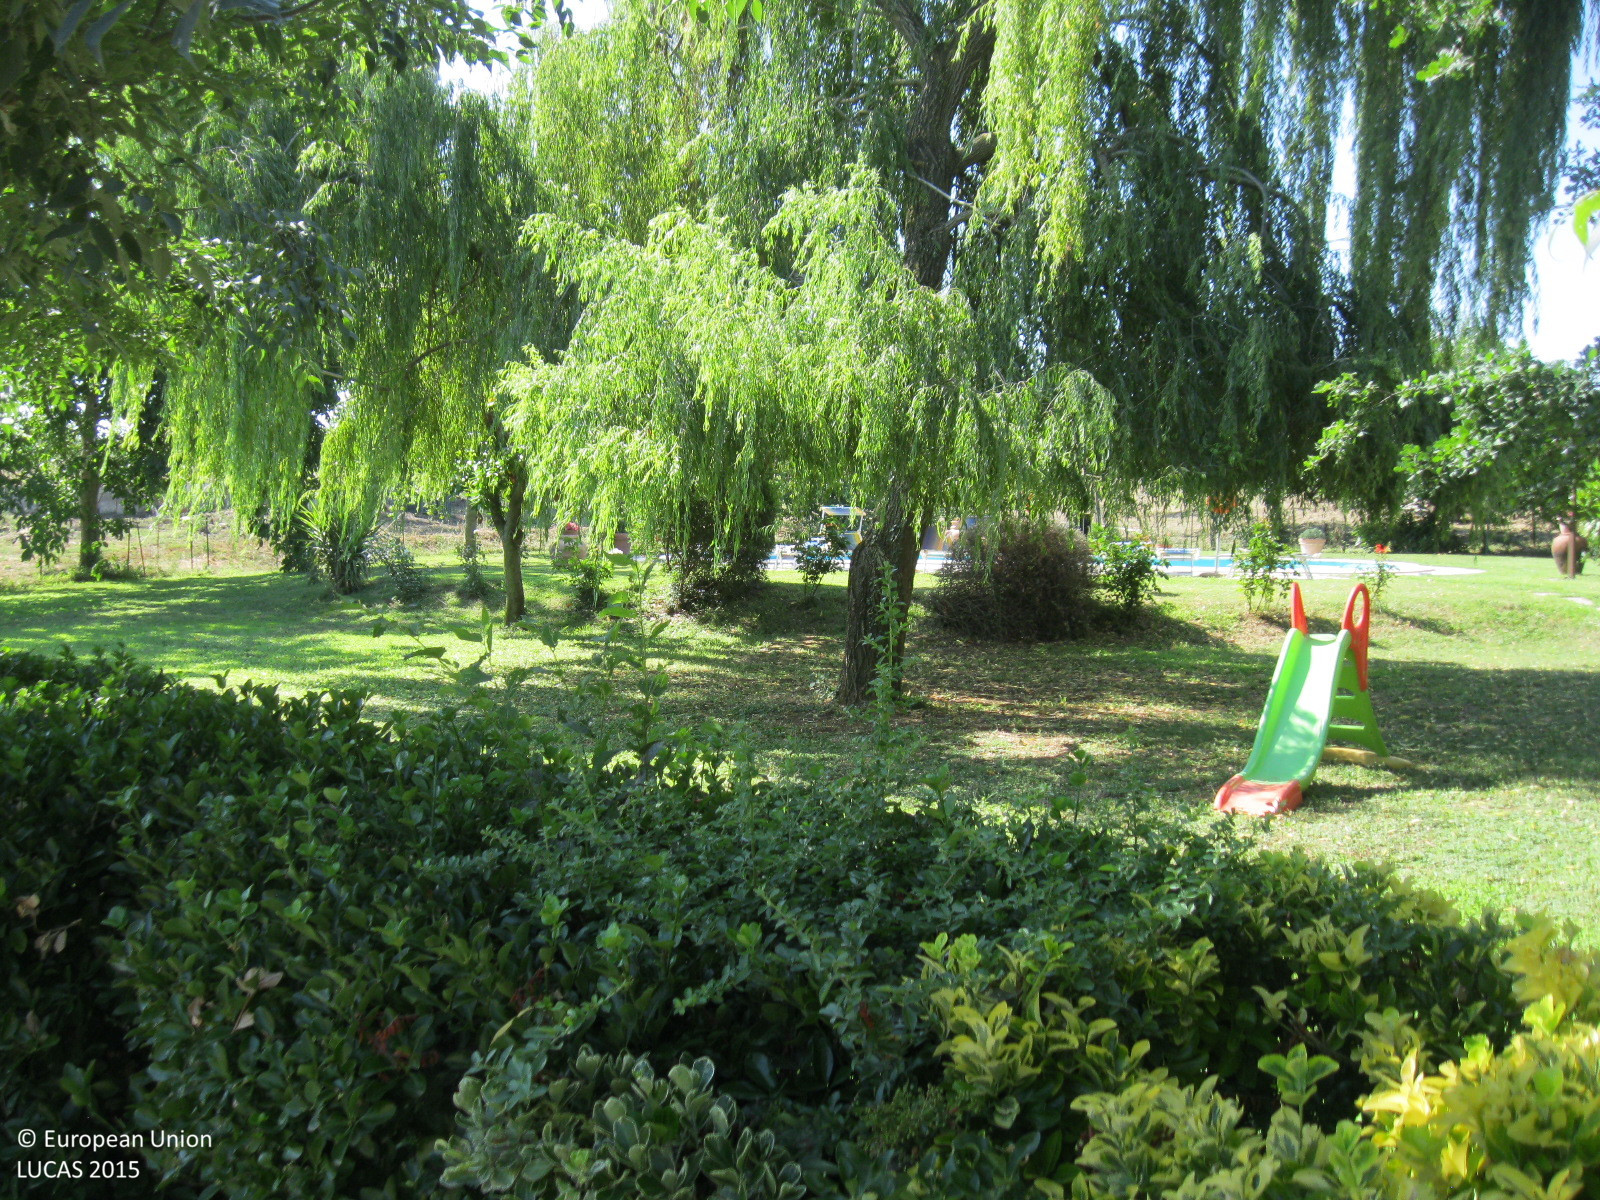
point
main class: Grassland
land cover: Grassland with sparse tree/shrub cover
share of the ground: 50 - 75 %
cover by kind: herbaceous plants 85 %, shrubs 10 %, broadleaved forest trees 5 %
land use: Amenities, museums, leisure
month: July
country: IT
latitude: 42.6430
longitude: 11.4952
